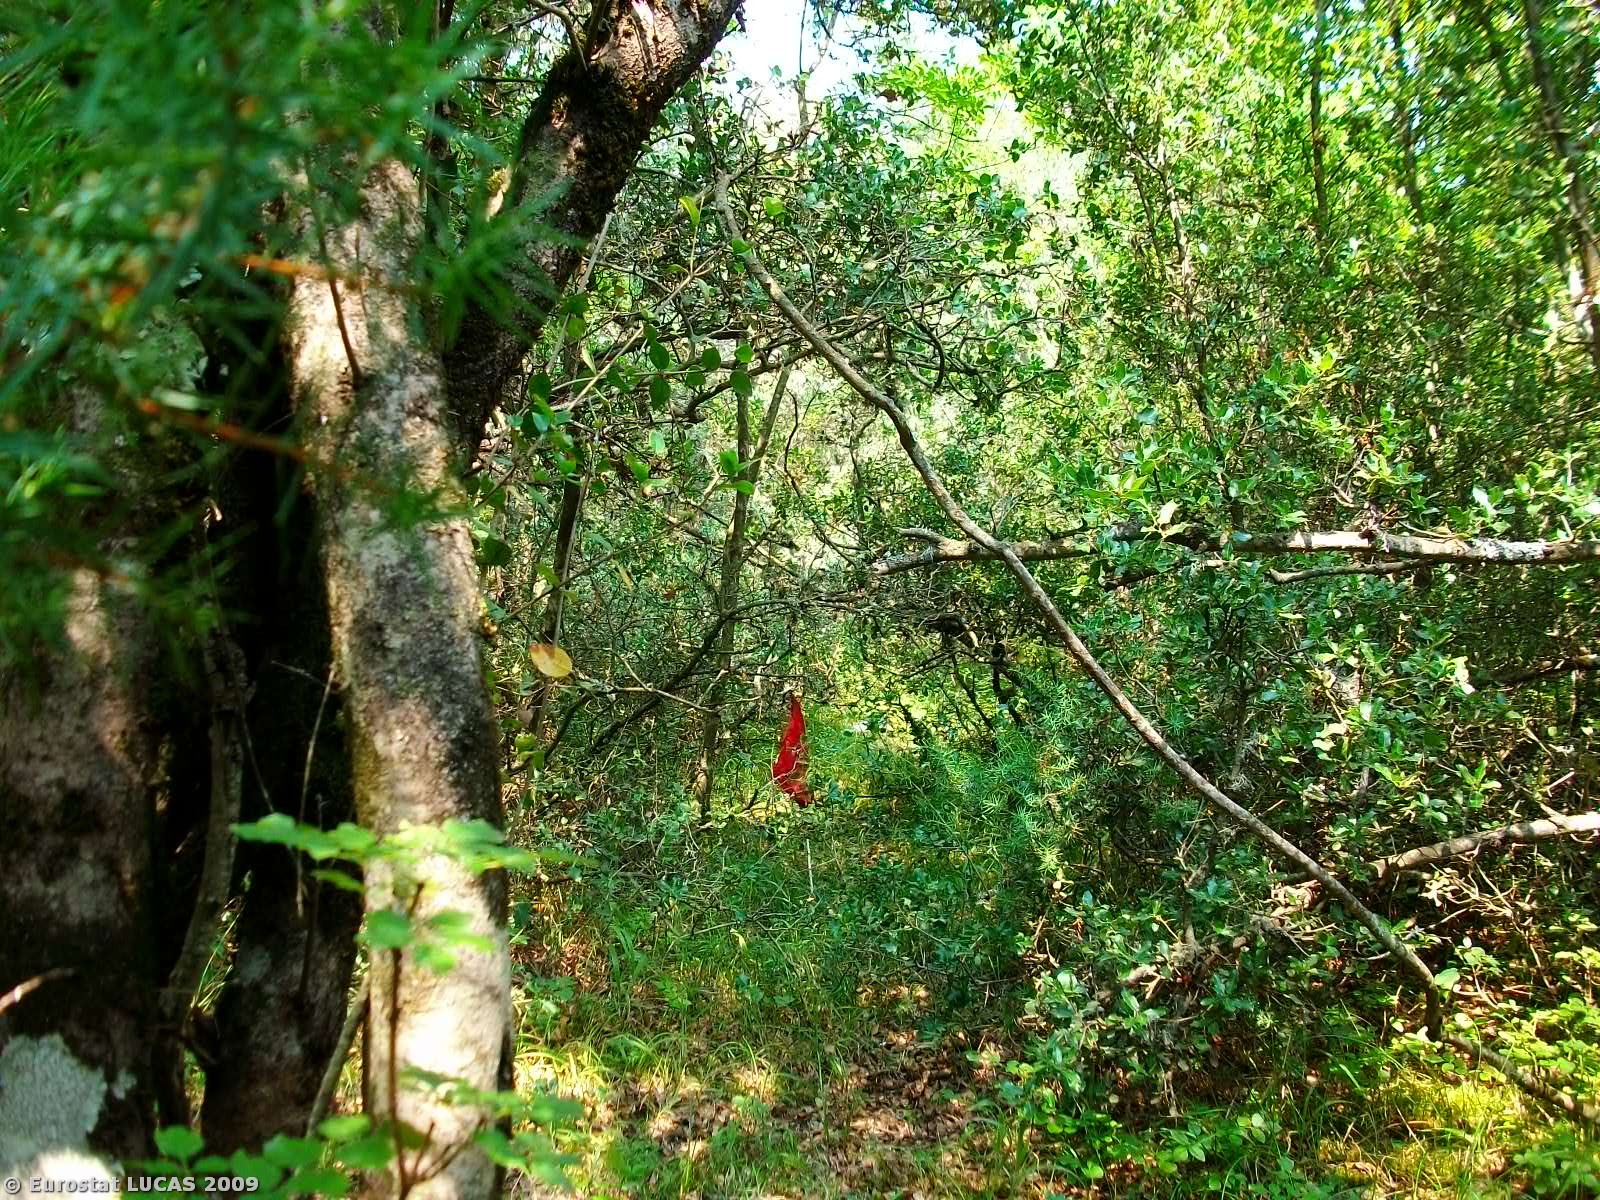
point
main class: Woodland
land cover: Broadleaved woodland
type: mesophytic deciduous forest
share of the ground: > 75 %
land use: Forestry
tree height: > 5 m
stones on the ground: 10 - 25 %
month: July
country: GR
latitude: 41.0560
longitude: 24.4904
